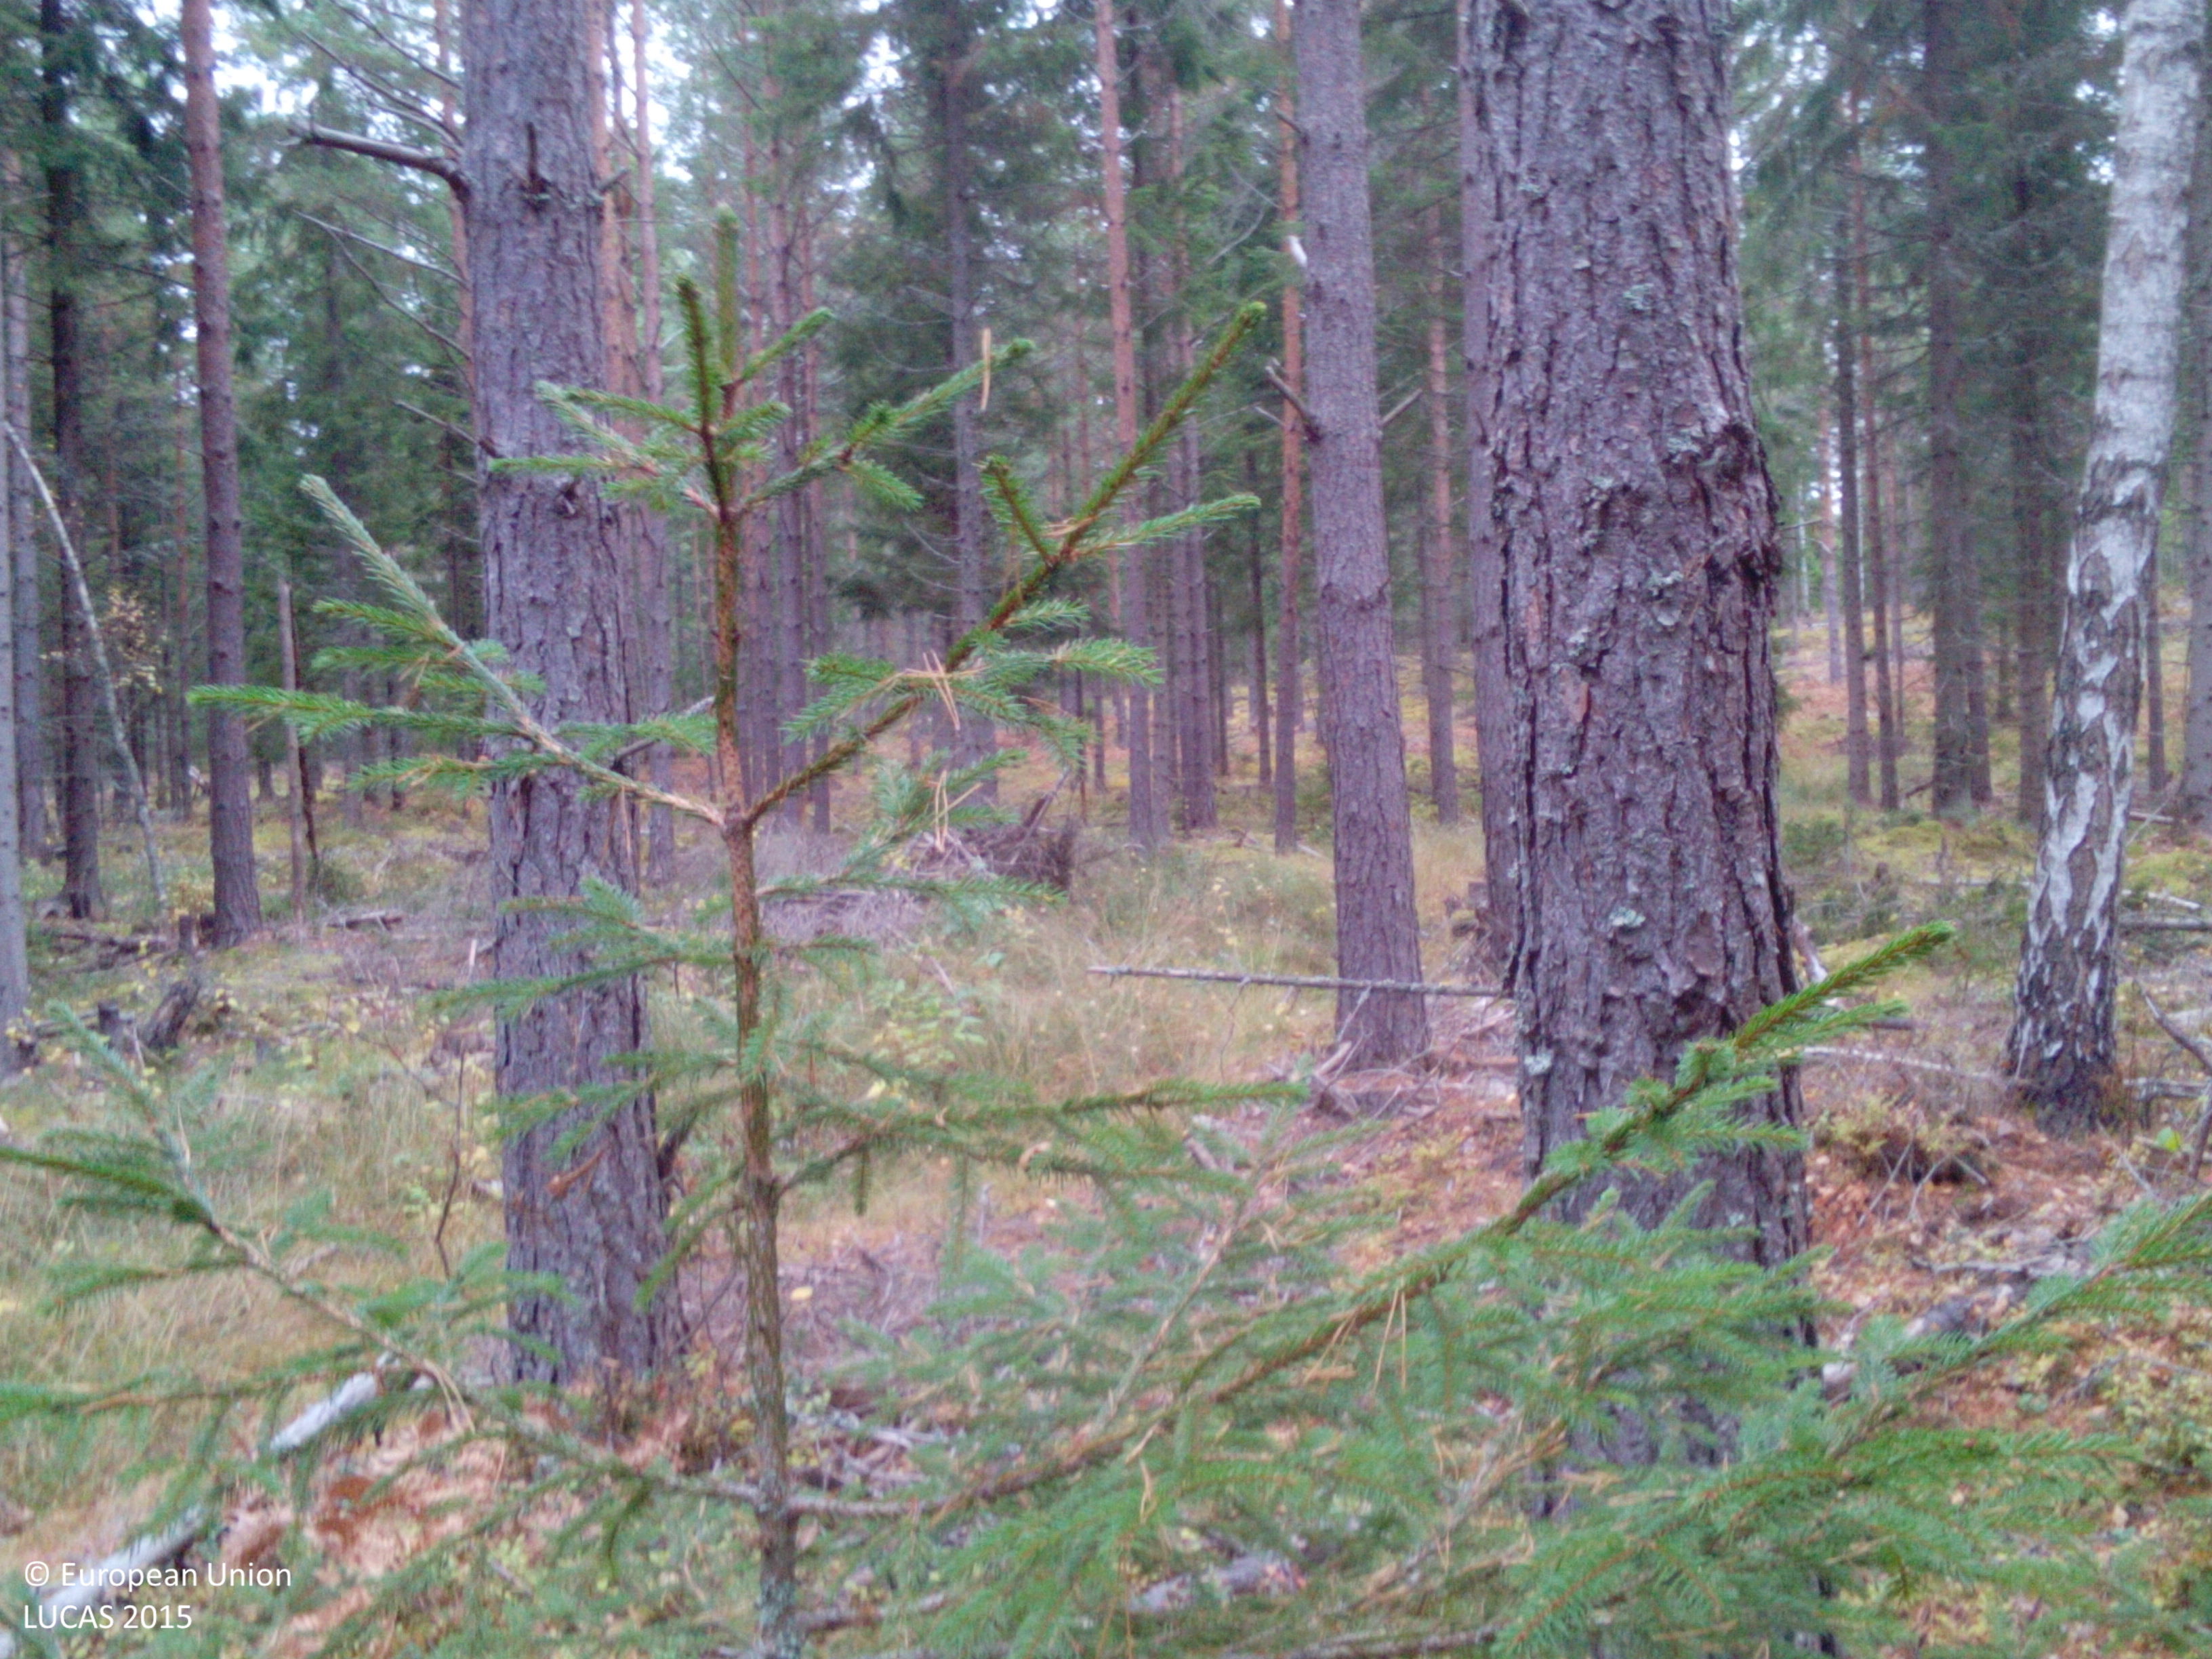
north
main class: Woodland
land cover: Other coniferous woodland
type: boreal forest
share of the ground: > 75 %
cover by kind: coniferous forest trees 75 %, herbaceous plants 10 %, lichens and mosses 10 %, broadleaved forest trees 5 %
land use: Forestry
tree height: > 5 m
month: October
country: SE
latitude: 59.1710
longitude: 16.3438
